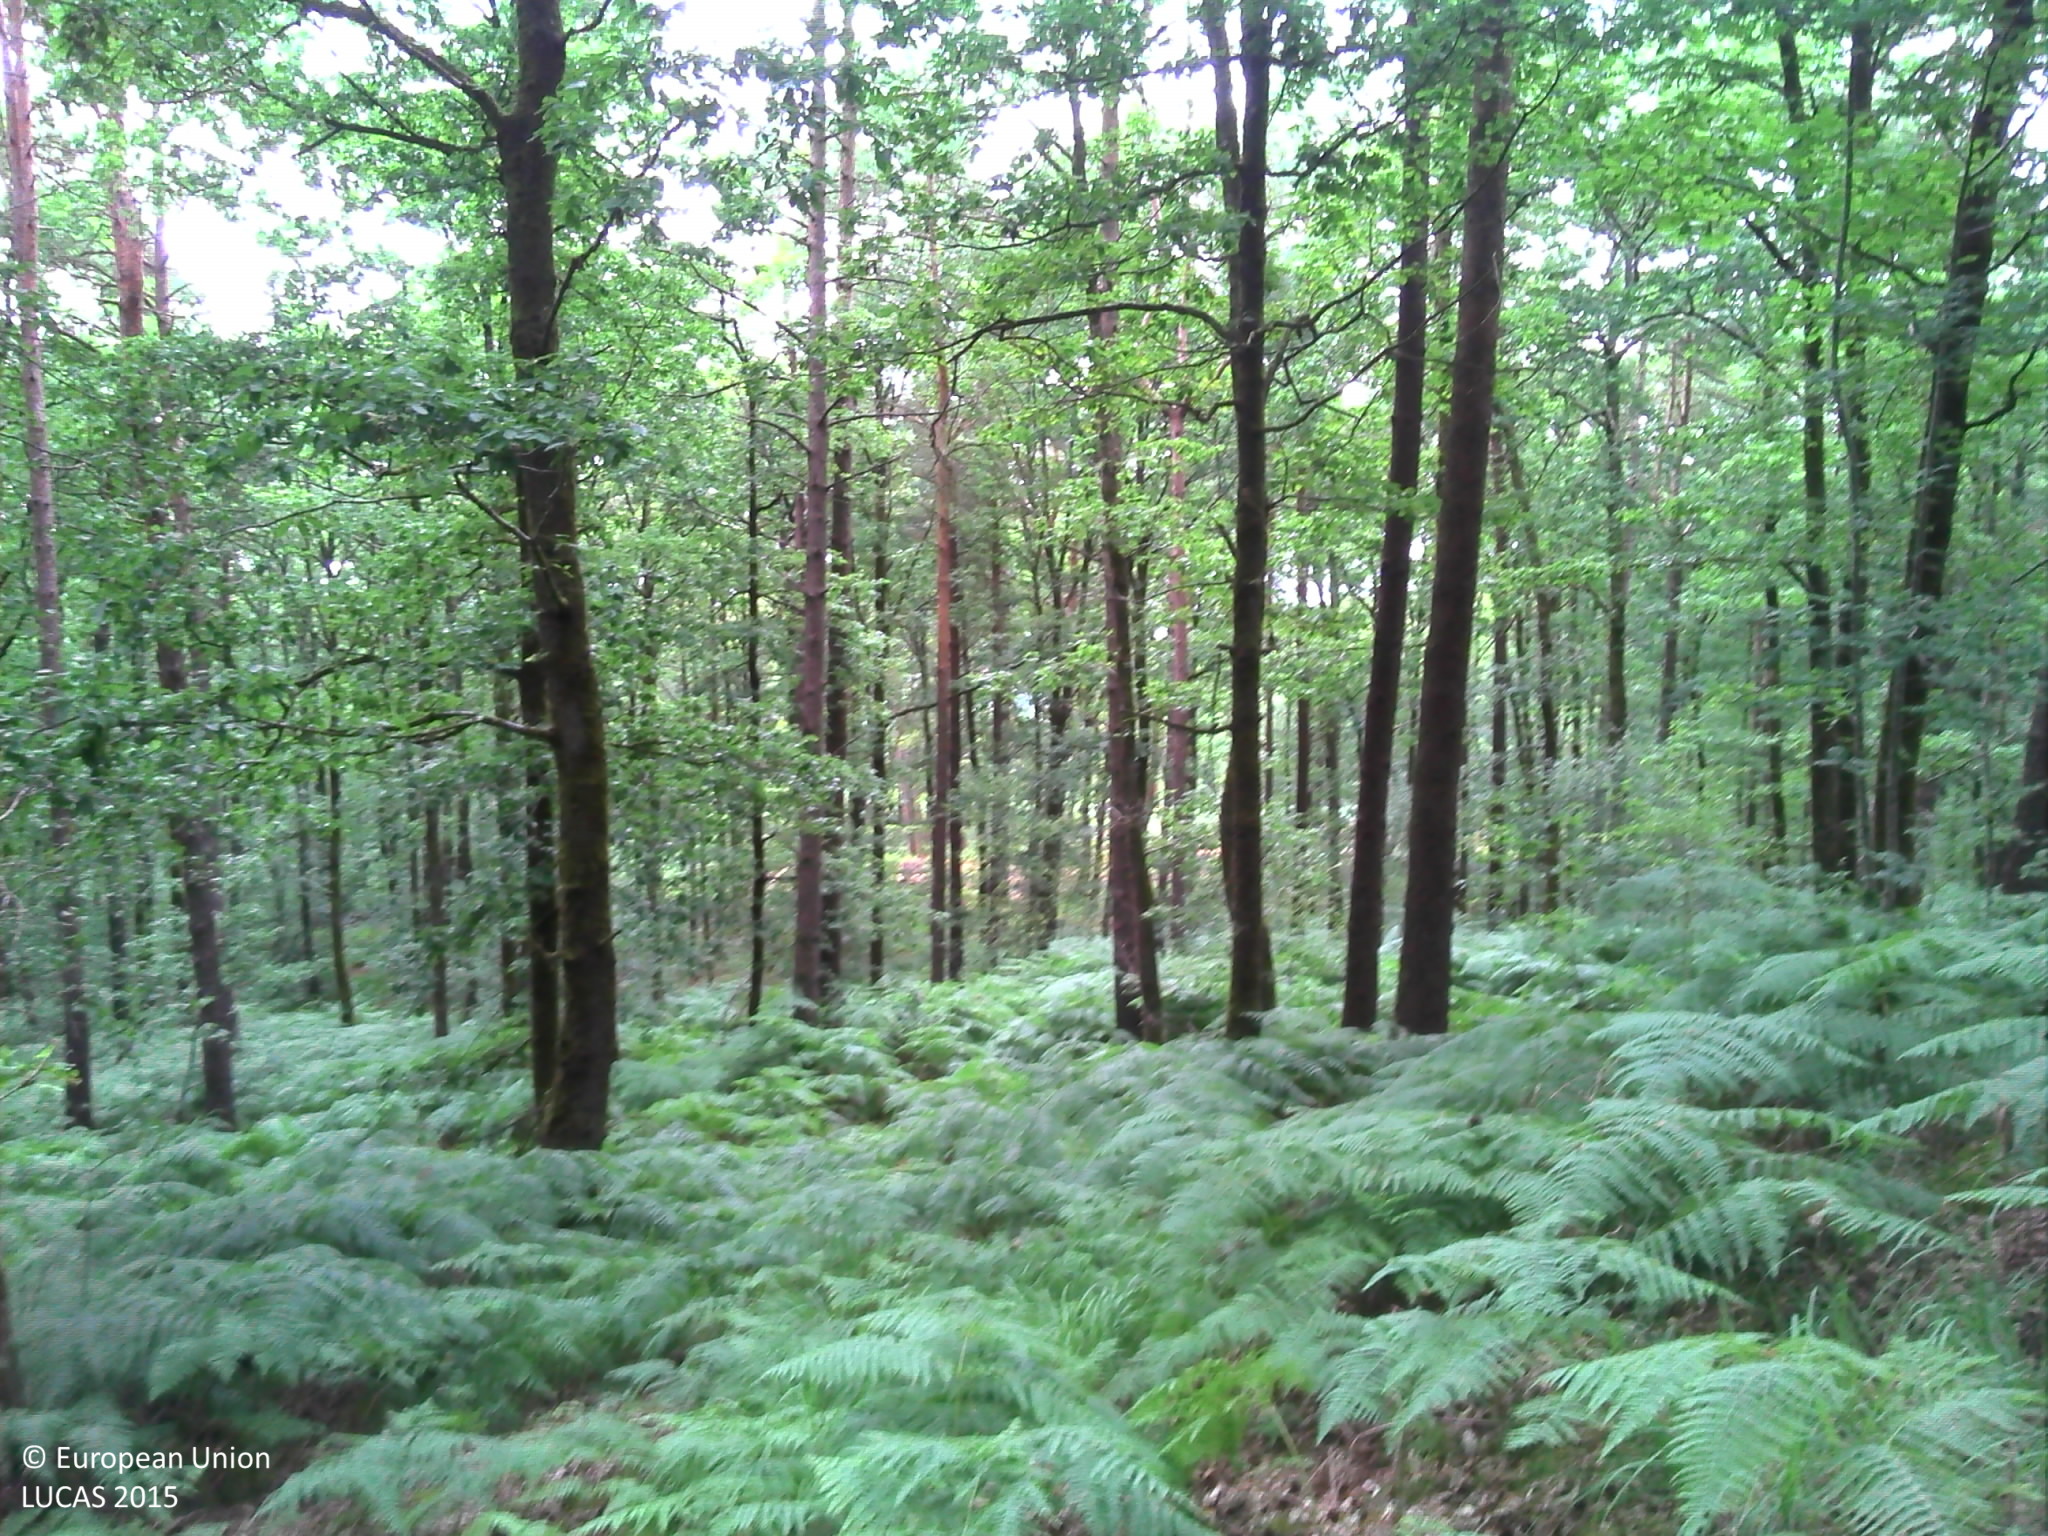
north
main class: Woodland
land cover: Pine dominated mixed woodland
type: acidophilous oak and oak-birch forest
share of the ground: > 75 %
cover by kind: broadleaved forest trees 50 %, coniferous forest trees 30 %, herbaceous plants 20 %
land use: Forestry
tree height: > 5 m
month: July
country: FR
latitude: 48.4473
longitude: -0.1026
